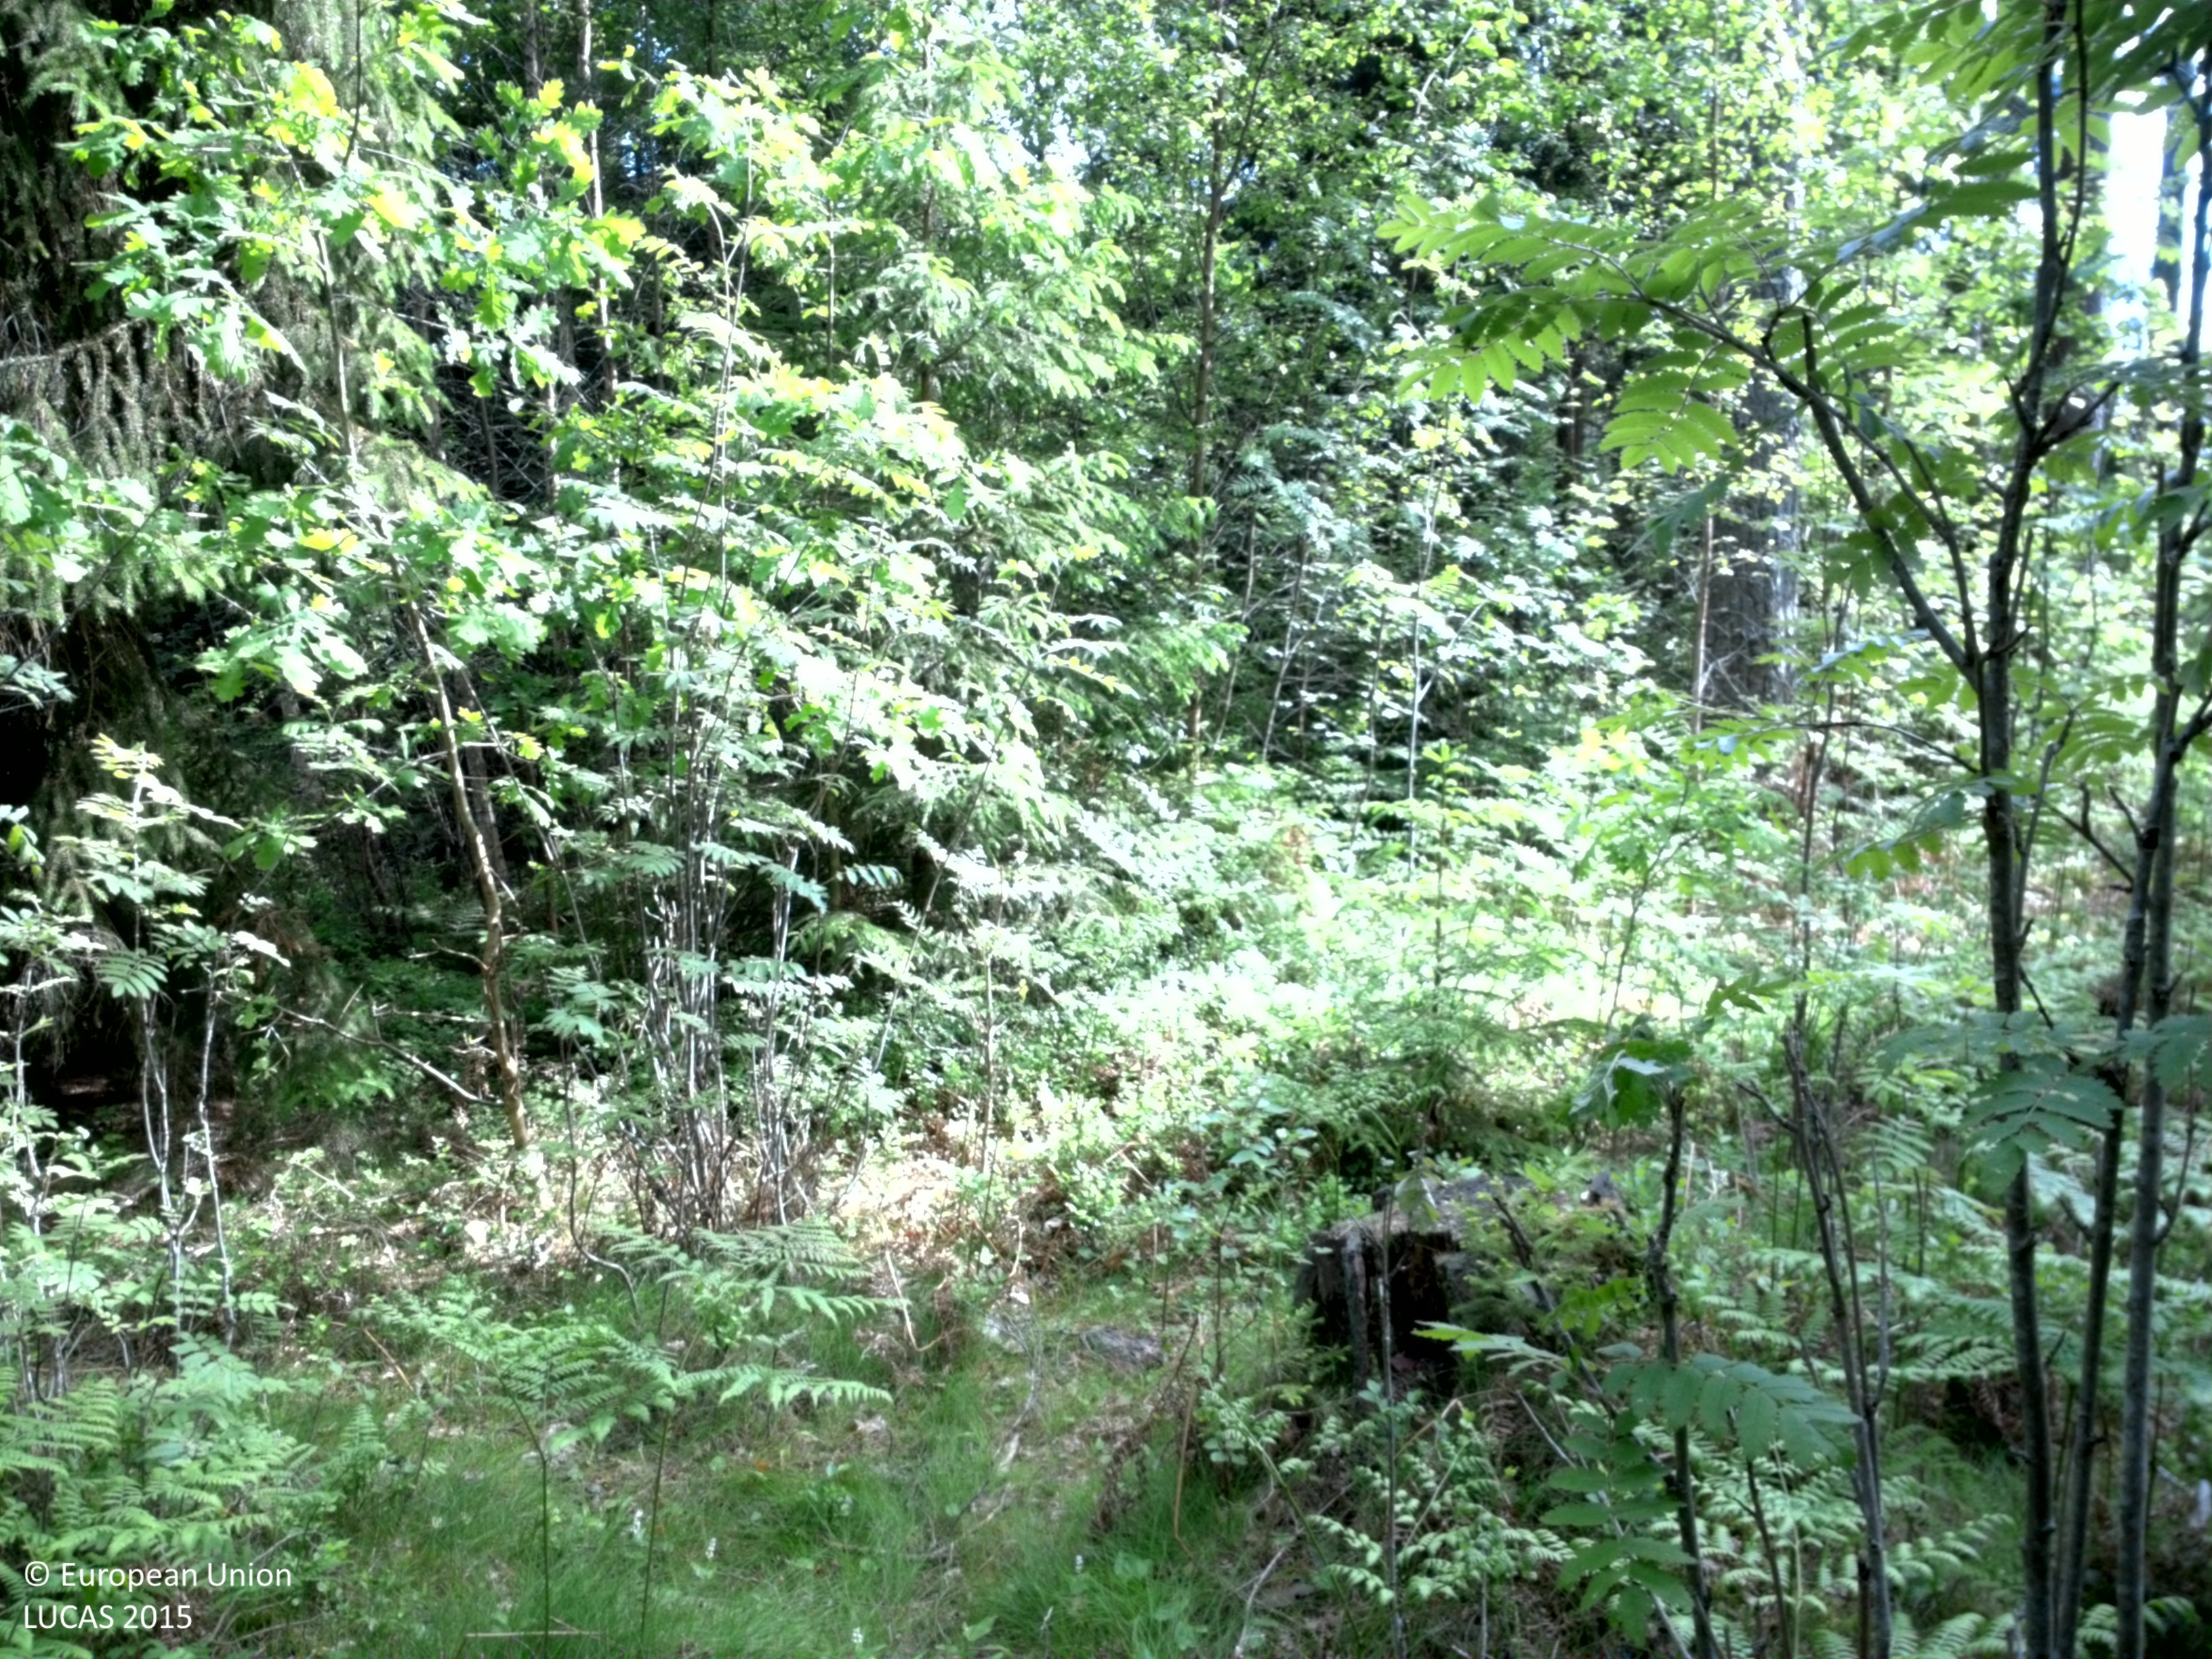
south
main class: Woodland
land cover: Pine dominated coniferous woodland
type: boreal forest
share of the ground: 10 - 25 %
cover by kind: herbaceous plants 45 %, lichens and mosses 30 %, coniferous forest trees 20 %, broadleaved forest trees 5 %
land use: Forestry
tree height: > 5 m
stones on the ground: < 10 %
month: June
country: SE
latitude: 58.5118
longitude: 15.2979
